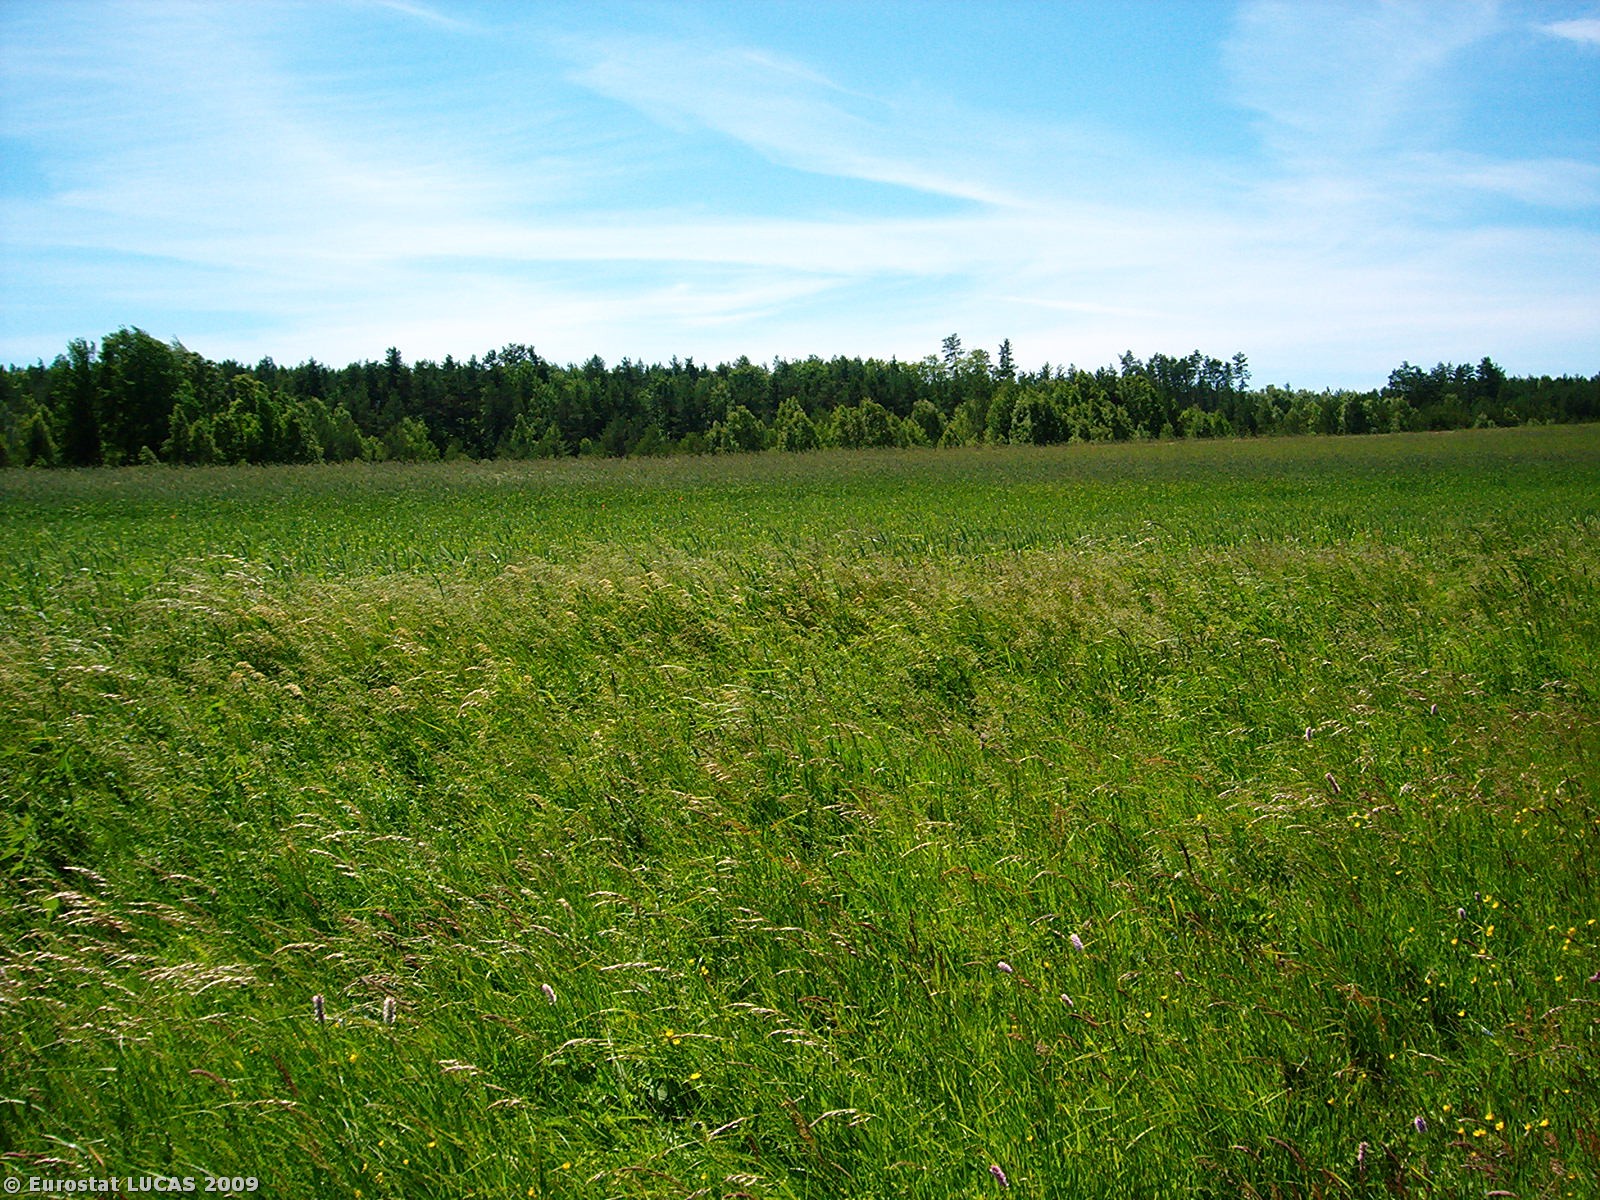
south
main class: Grassland
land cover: Grassland without tree/shrub cover
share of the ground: > 75 %
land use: Unused
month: June
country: PL
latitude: 53.8196
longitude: 17.1946
